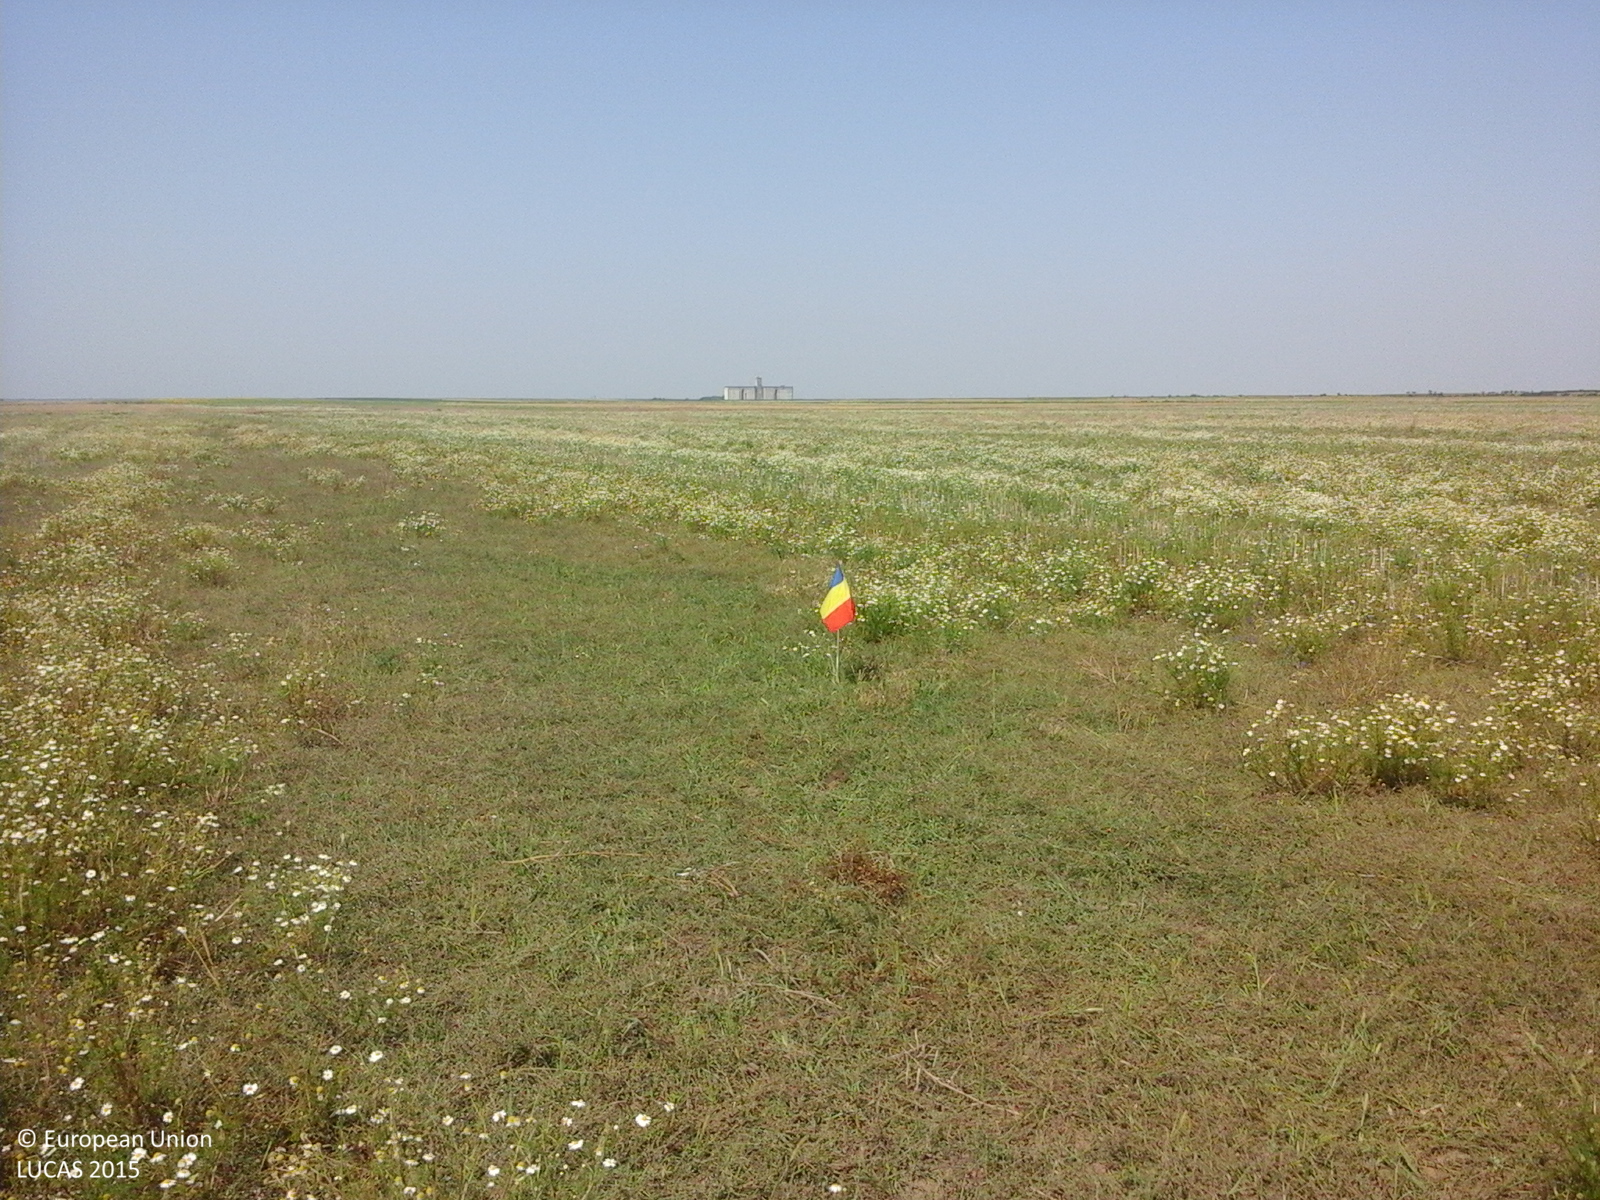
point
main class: Grassland
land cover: Spontaneously vegetated surfaces
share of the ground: < 10 %
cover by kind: herbaceous plants 100 %
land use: Fallow land
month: July
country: RO
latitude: 44.1923
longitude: 25.3366
